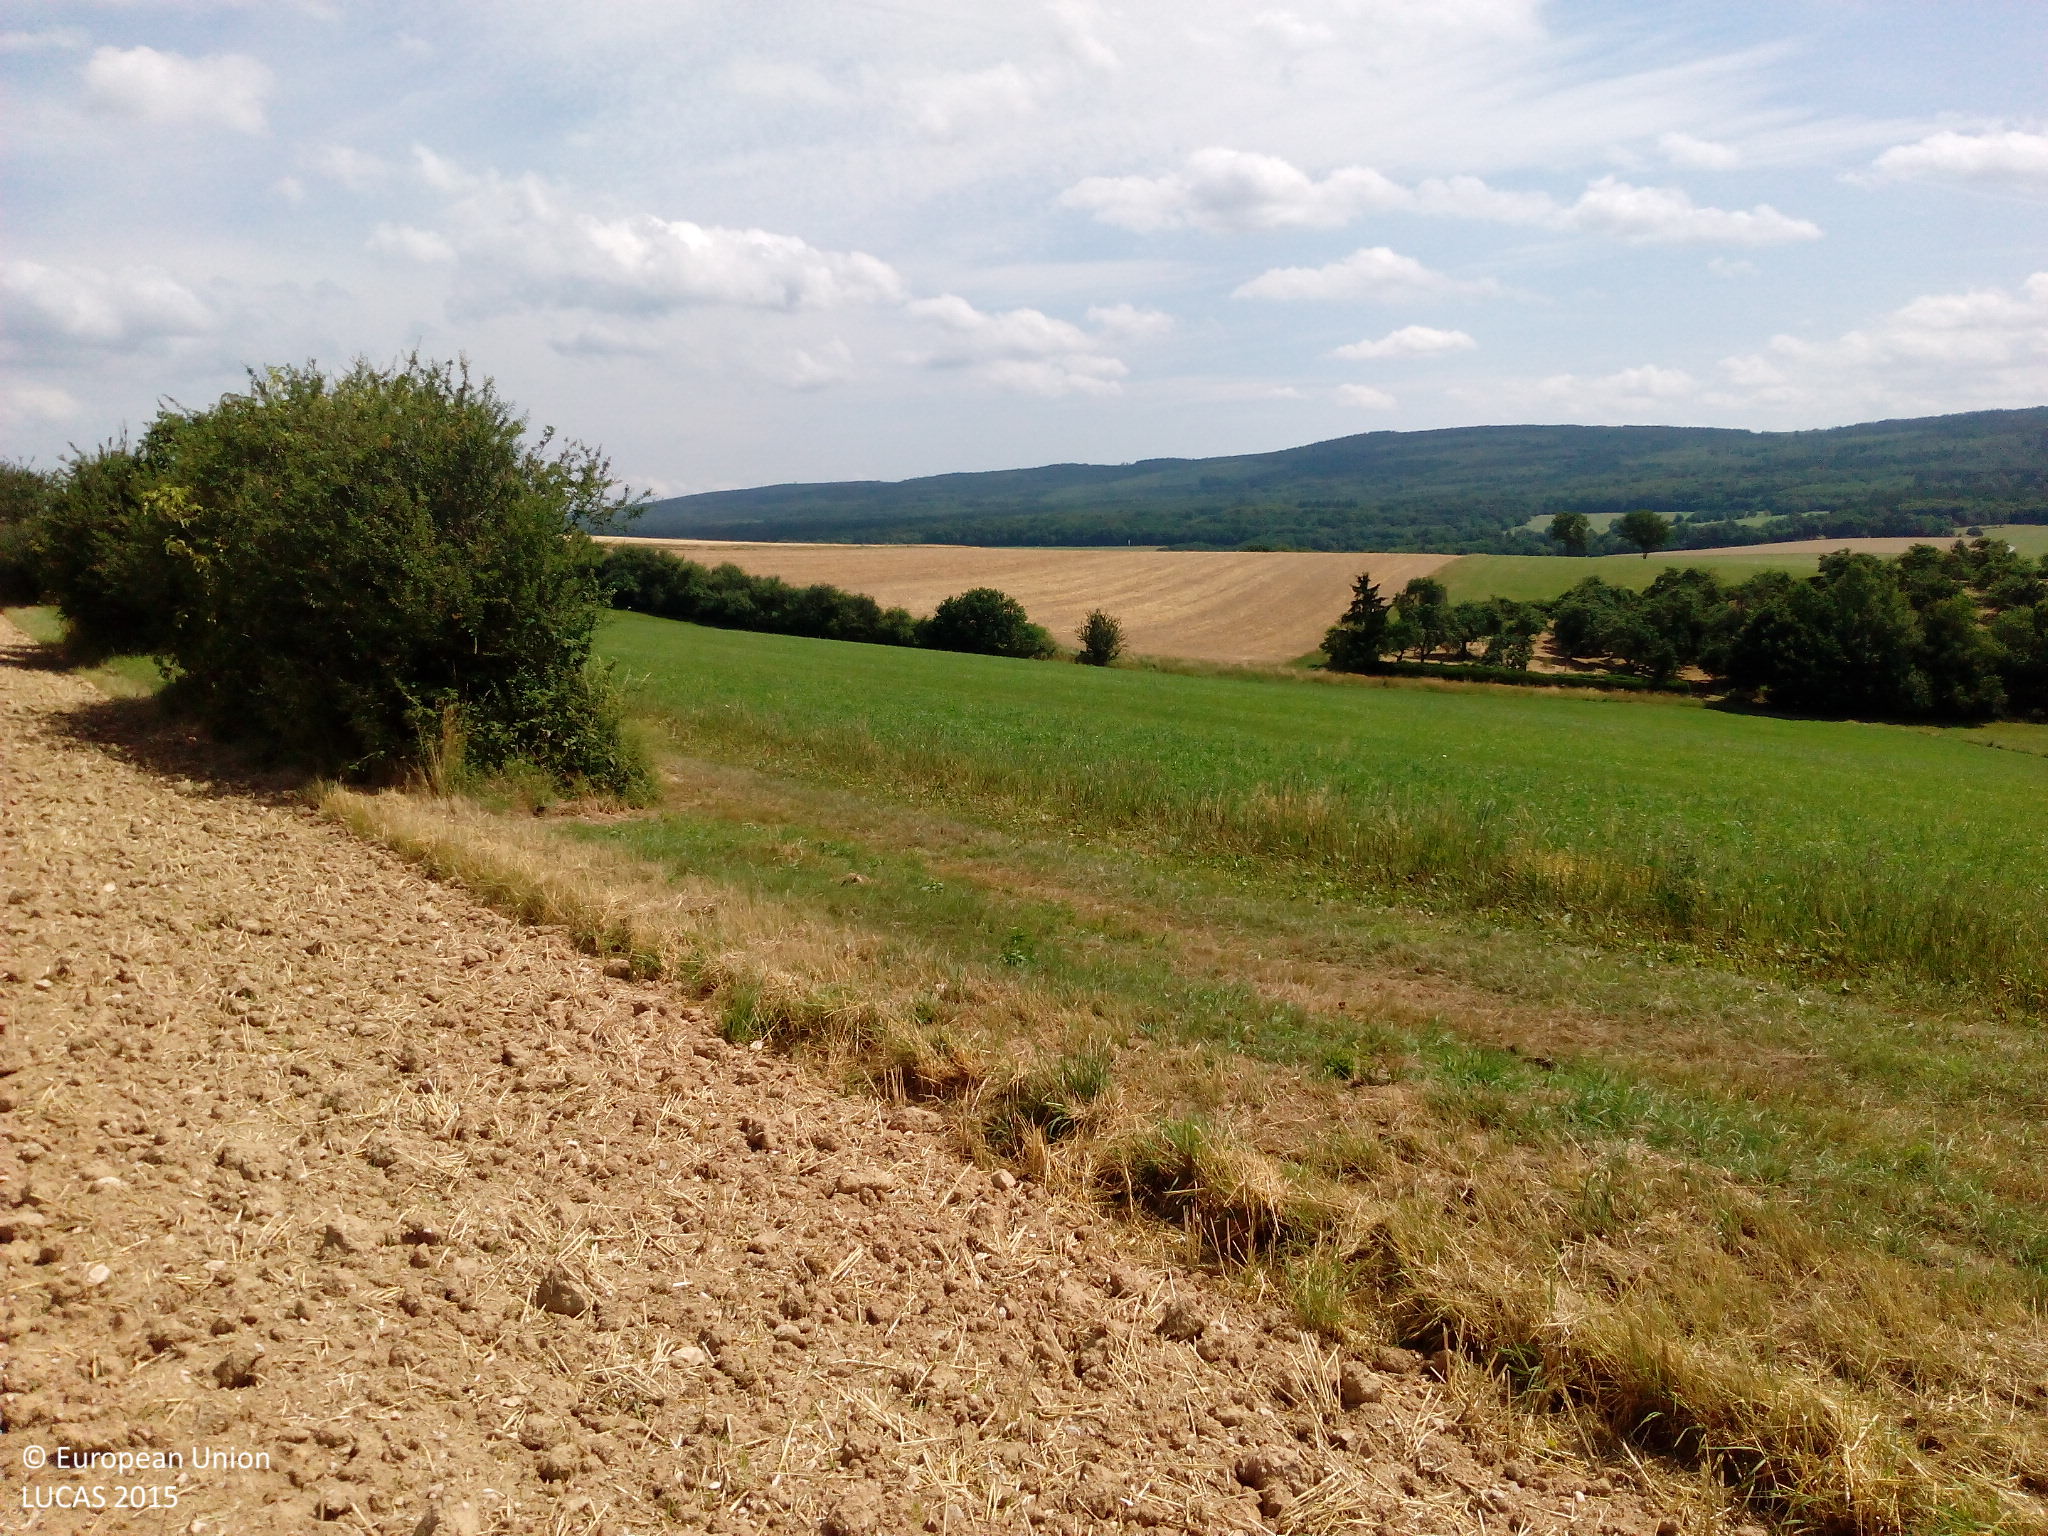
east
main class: Cropland
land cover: Barley
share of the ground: < 10 %
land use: Agriculture (excluding fallow land and kitchen gardens)
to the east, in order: Barley; Grassland without tree/shrub cover; Temporary grasslands; Grassland without tree/shrub cover; Other bare soil
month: July
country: DE
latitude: 49.9417
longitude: 7.5340
